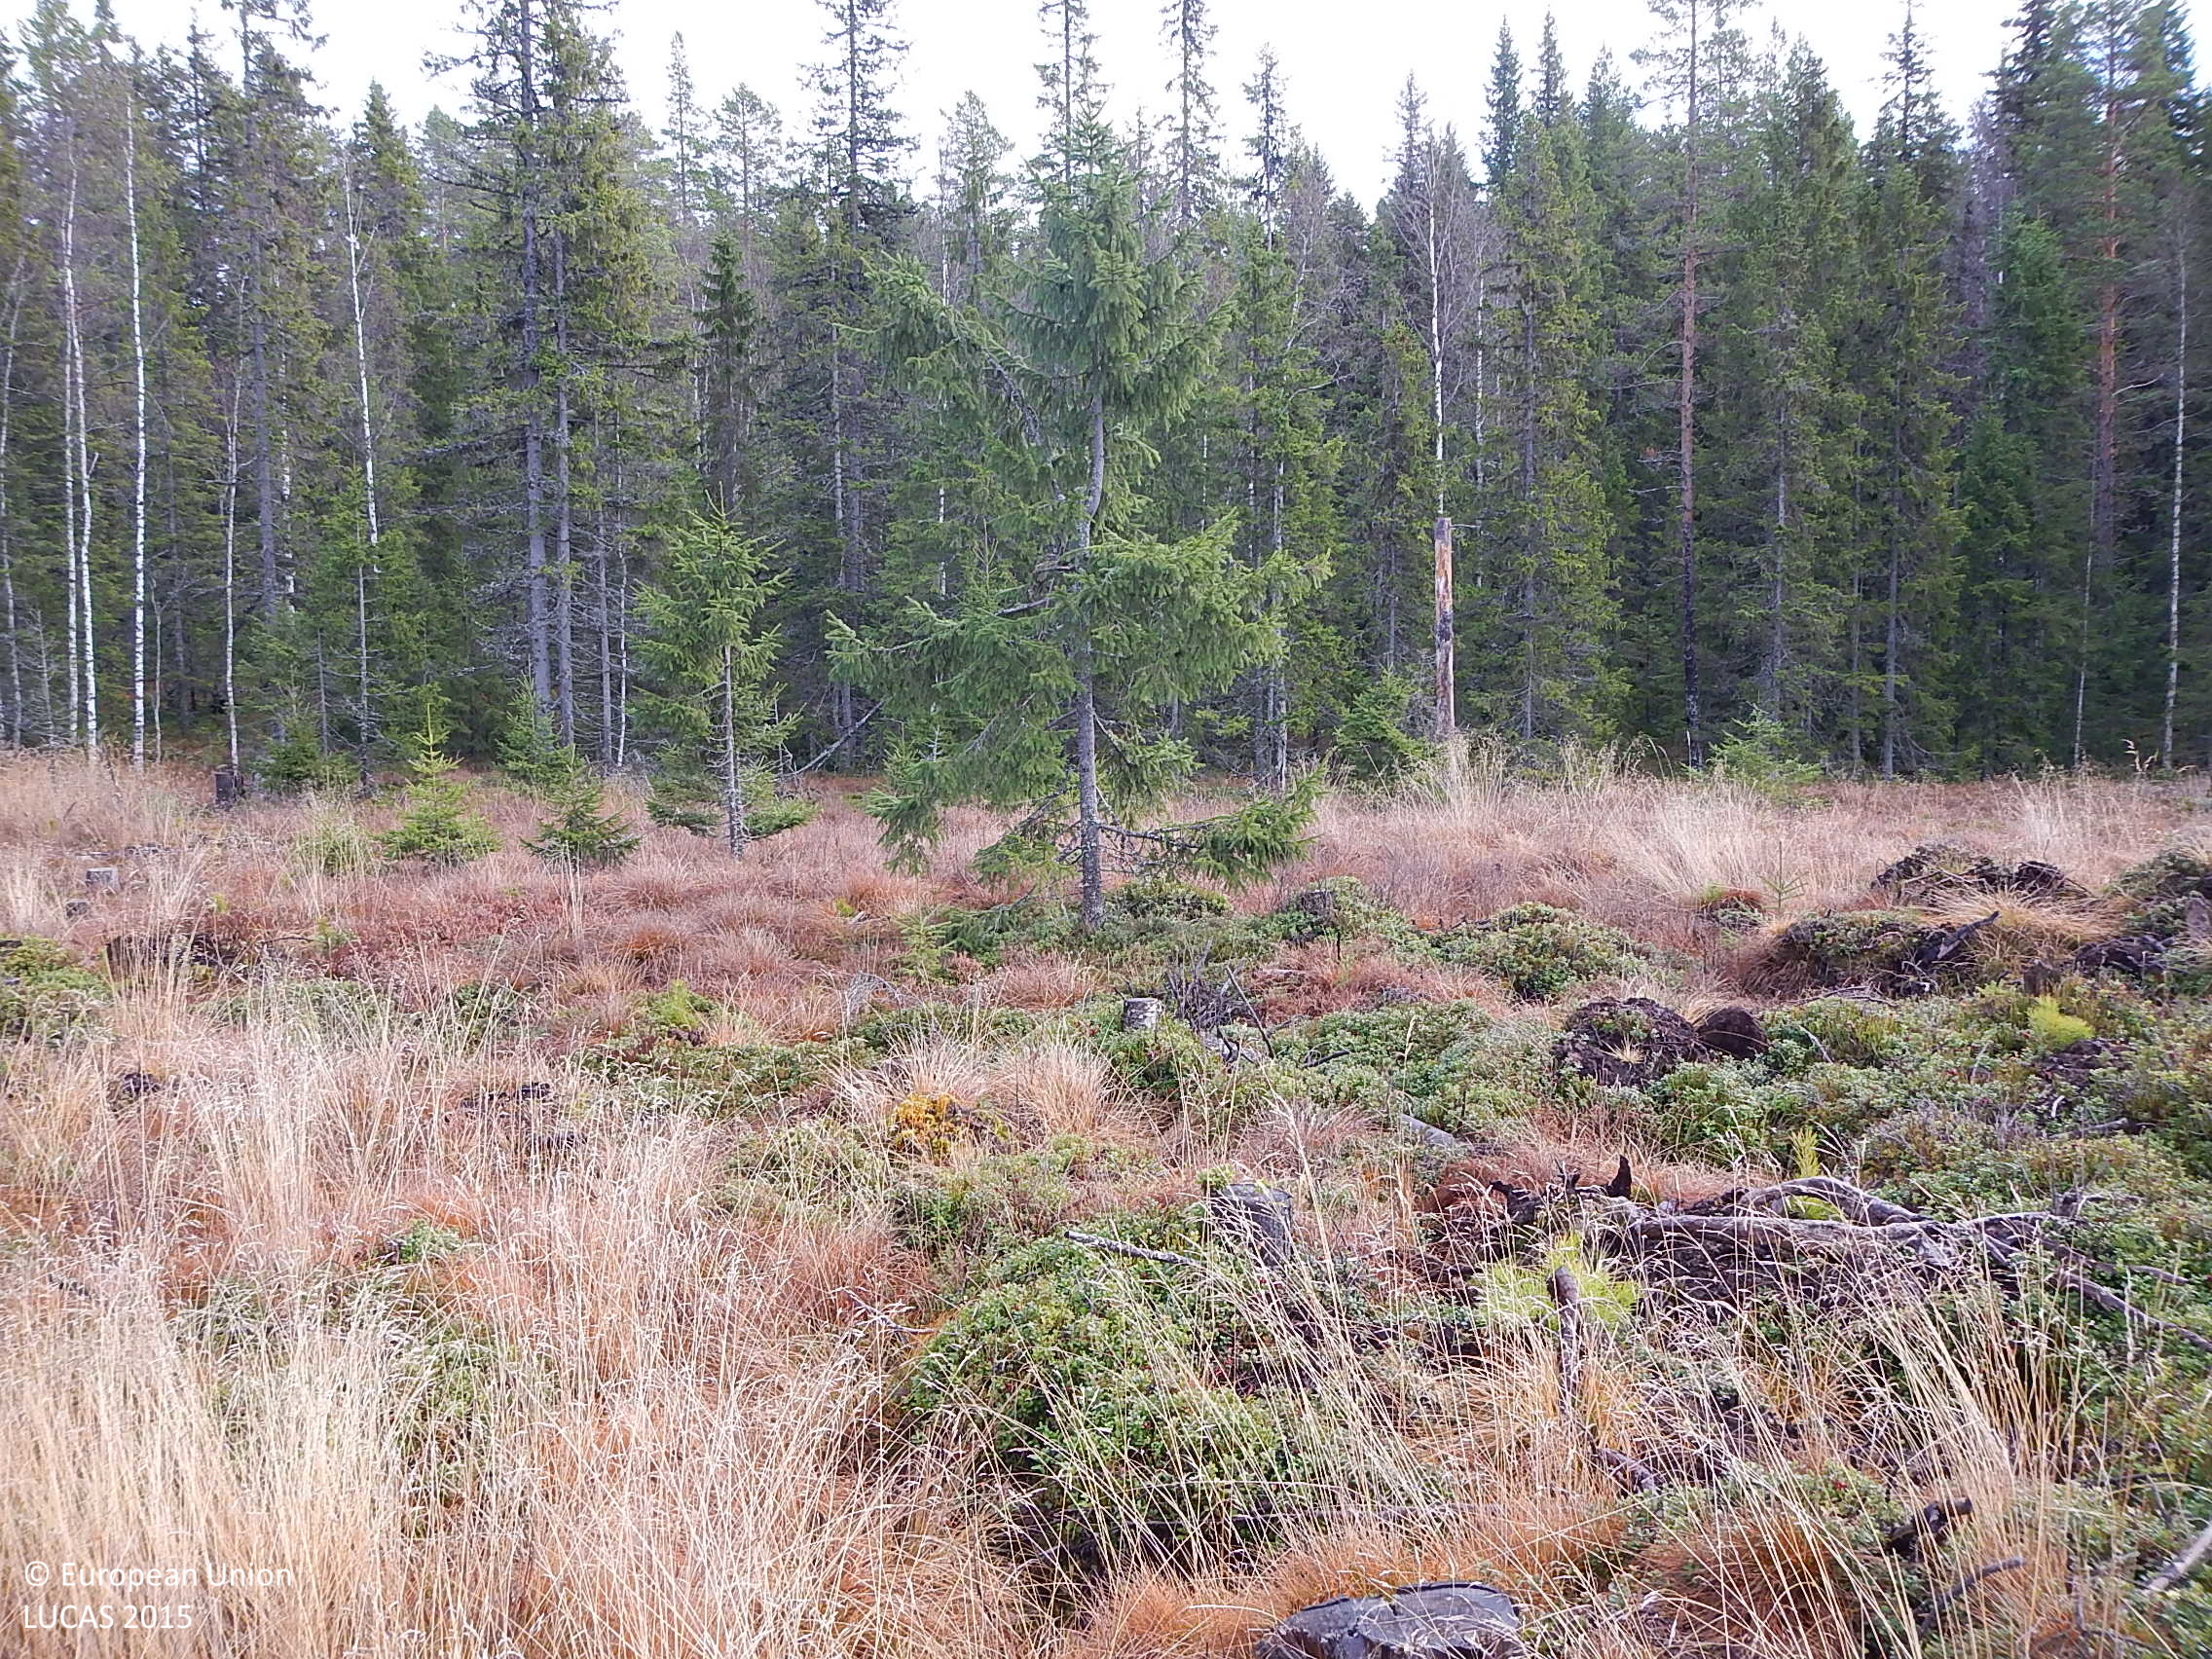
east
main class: Shrubland
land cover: Shrubland with sparse tree cover
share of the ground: > 75 %
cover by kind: shrubs 50 %, herbaceous plants 35 %, coniferous forest trees 5 %, lichens and mosses 5 %, unconsolidated bare surface 5 %
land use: Forestry
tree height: < 5 m
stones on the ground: < 10 %
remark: Clear cut
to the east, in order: Shrubland with sparse tree cover; Spruce dominated coniferous woodland; Rivers and streams; Spruce dominated coniferous woodland; Other coniferous woodland; Spruce dominated coniferous woodland
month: November
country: SE
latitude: 61.1150
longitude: 16.0911
